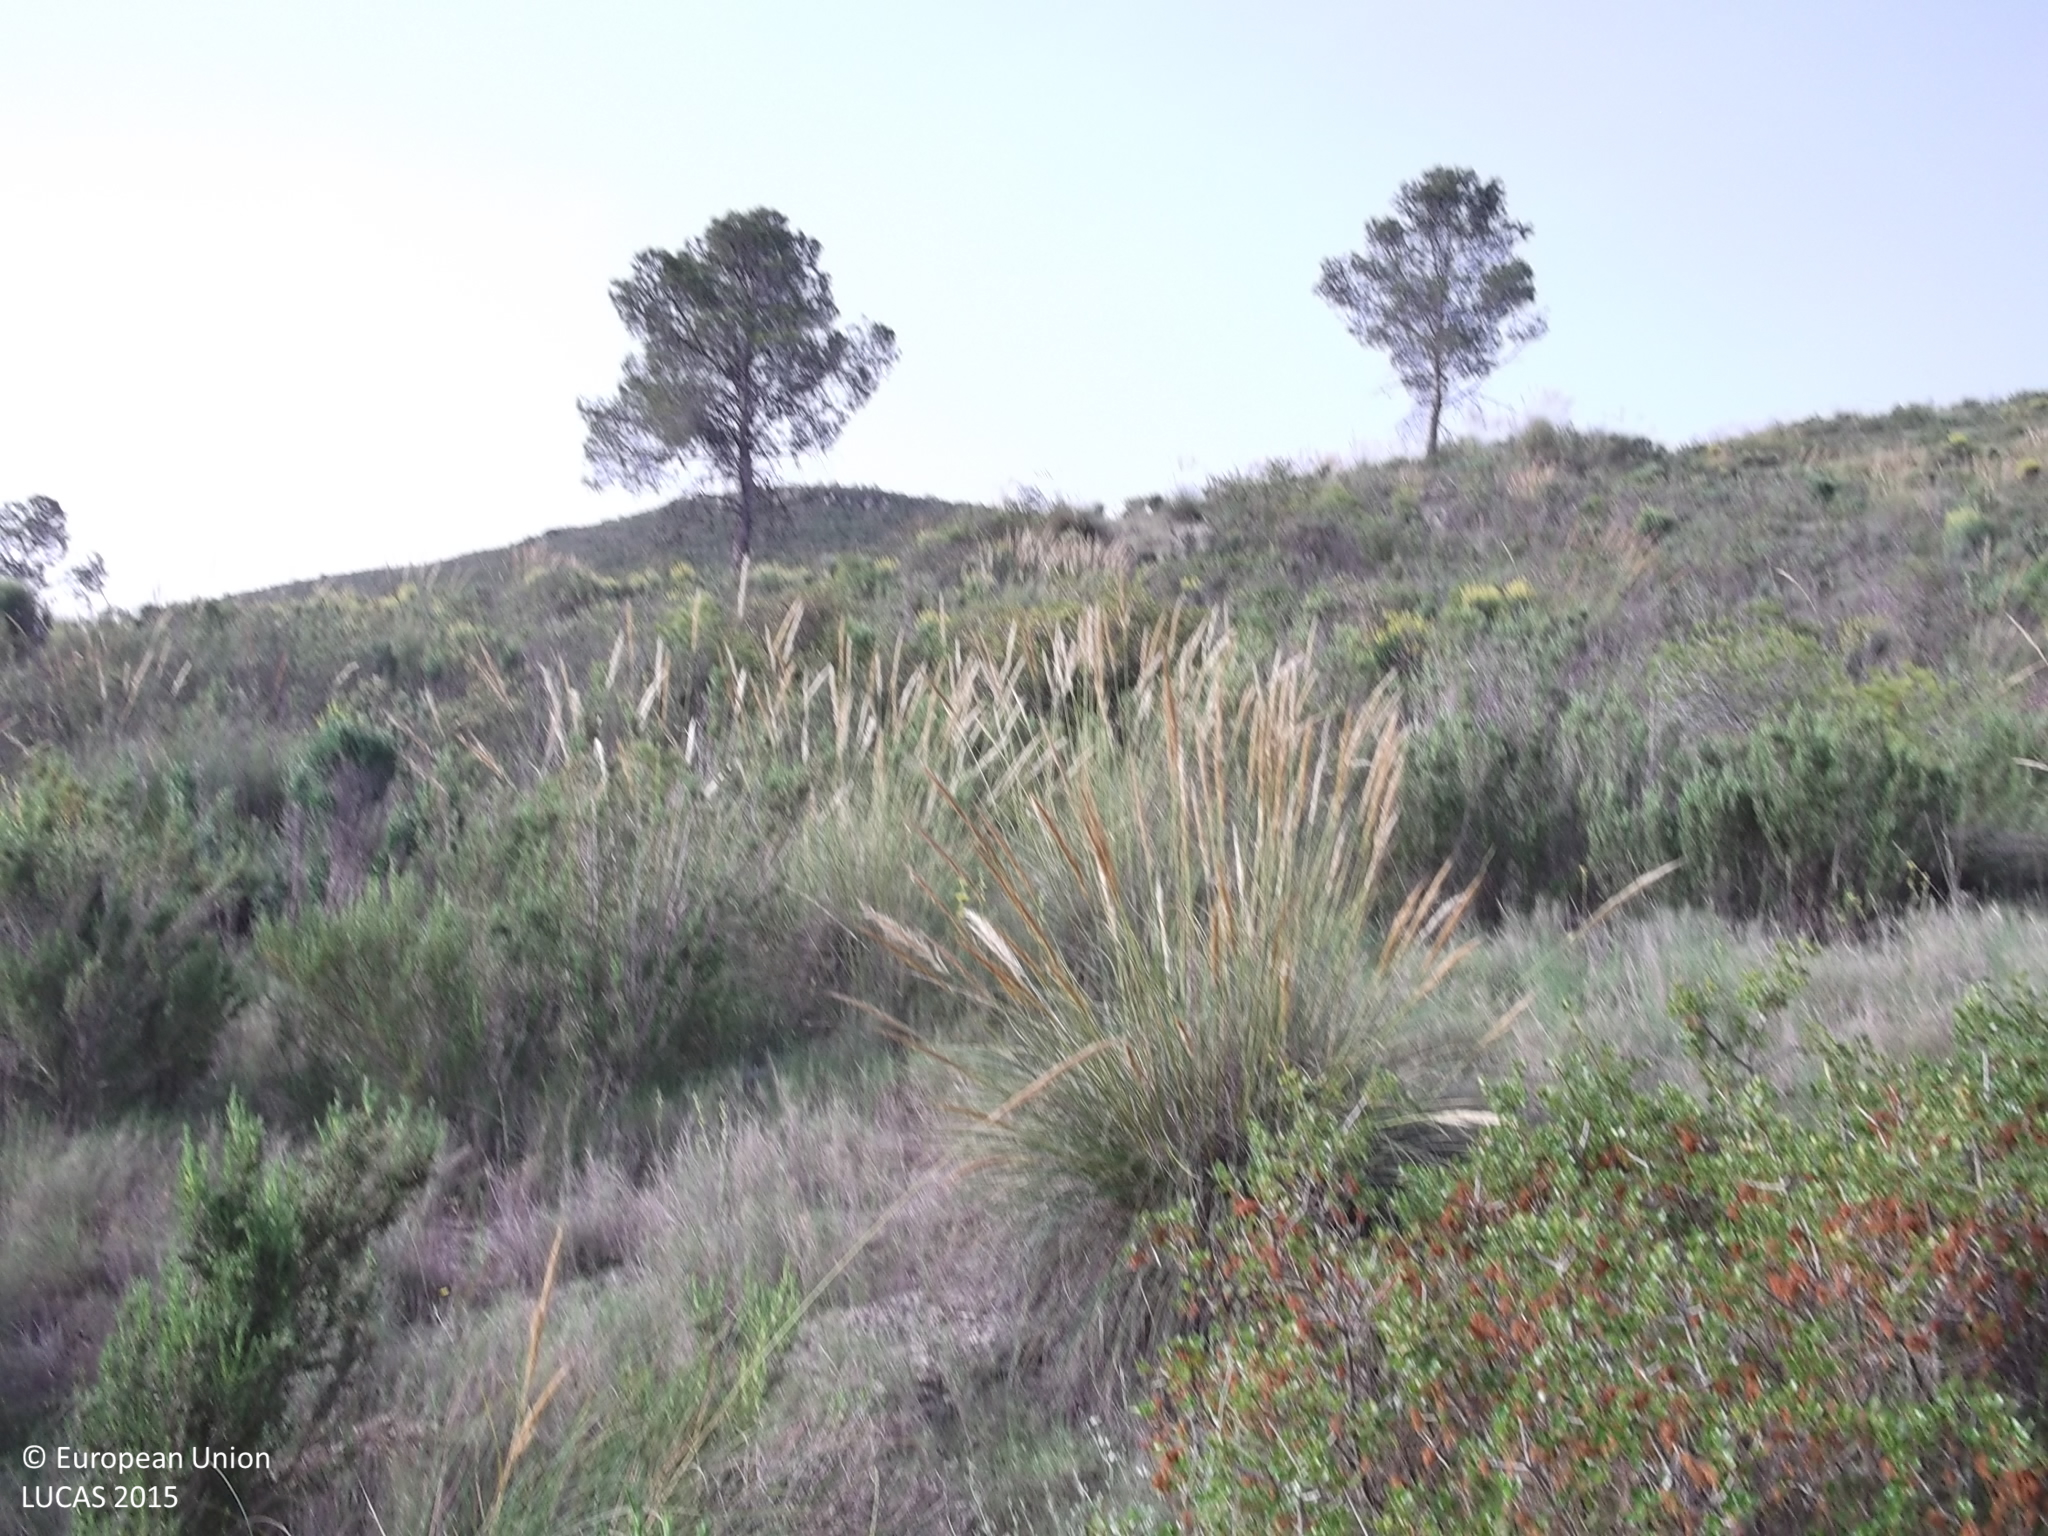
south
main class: Shrubland
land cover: Shrubland with sparse tree cover
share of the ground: 25 - 50 %
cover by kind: shrubs 40 %, herbaceous plants 40 %, consolidated bare surface 15 %, coniferous forest trees 5 %
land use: Semi-natural and natural areas not in use
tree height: > 5 m
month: May
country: ES
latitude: 38.3160
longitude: -1.5992
